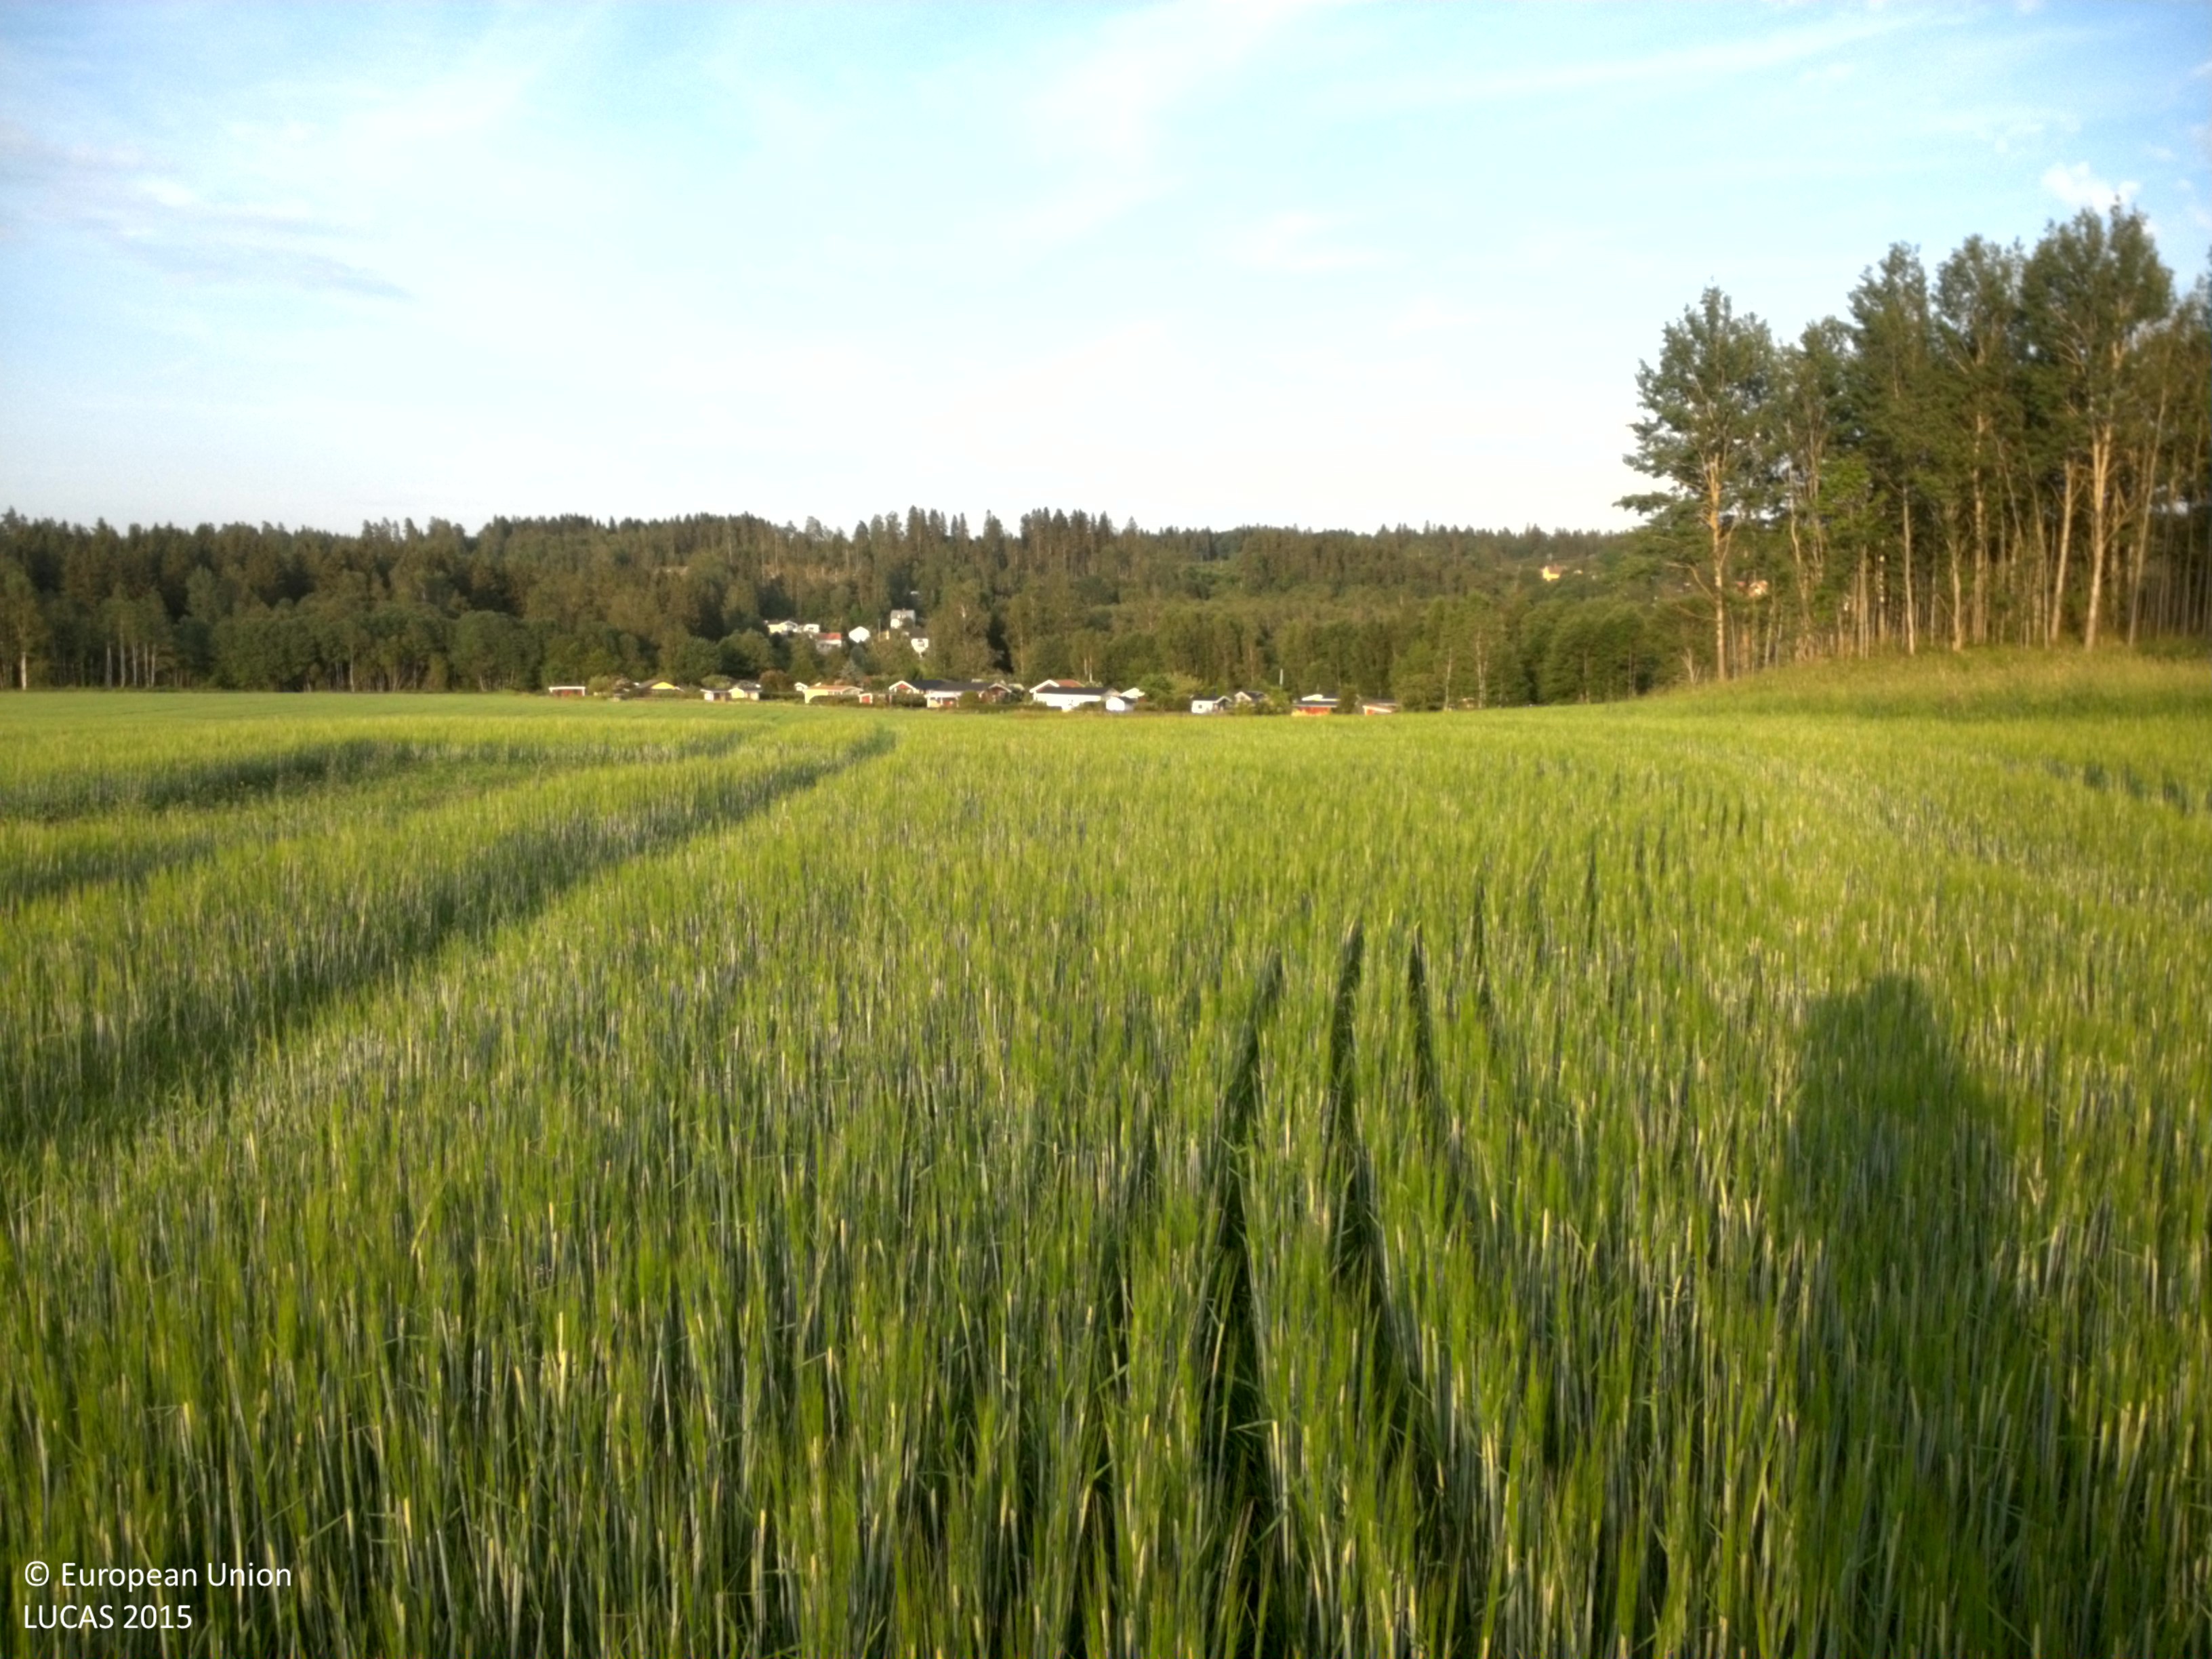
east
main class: Cropland
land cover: Barley
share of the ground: > 75 %
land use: Agriculture (excluding fallow land and kitchen gardens)
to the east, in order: Barley; Shruby margins; Ditches and canals; Artificial constructions in urban areas
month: July
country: SE
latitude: 59.3311
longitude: 14.5789
